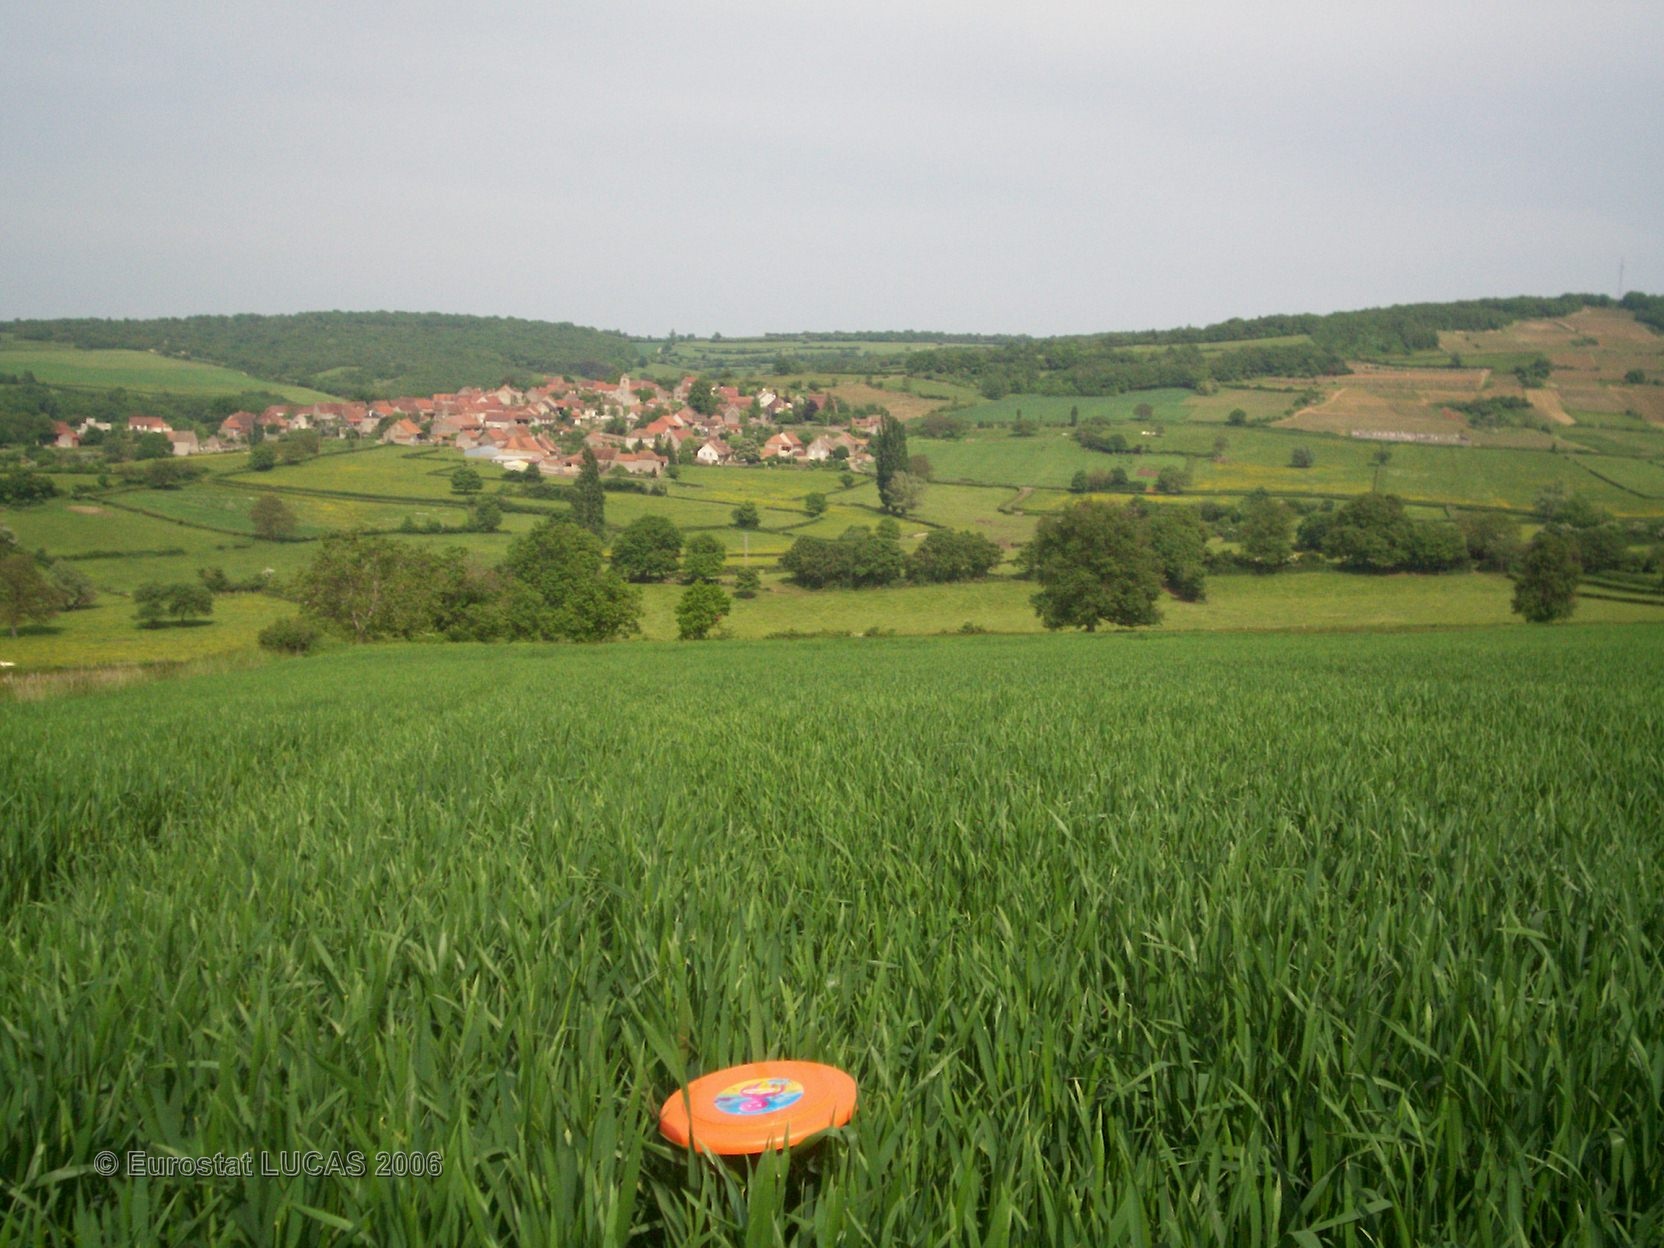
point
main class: Cropland
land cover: Common wheat
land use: Agriculture (excluding fallow land and kitchen gardens)
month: May
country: FR
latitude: 46.6675
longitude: 4.6292
